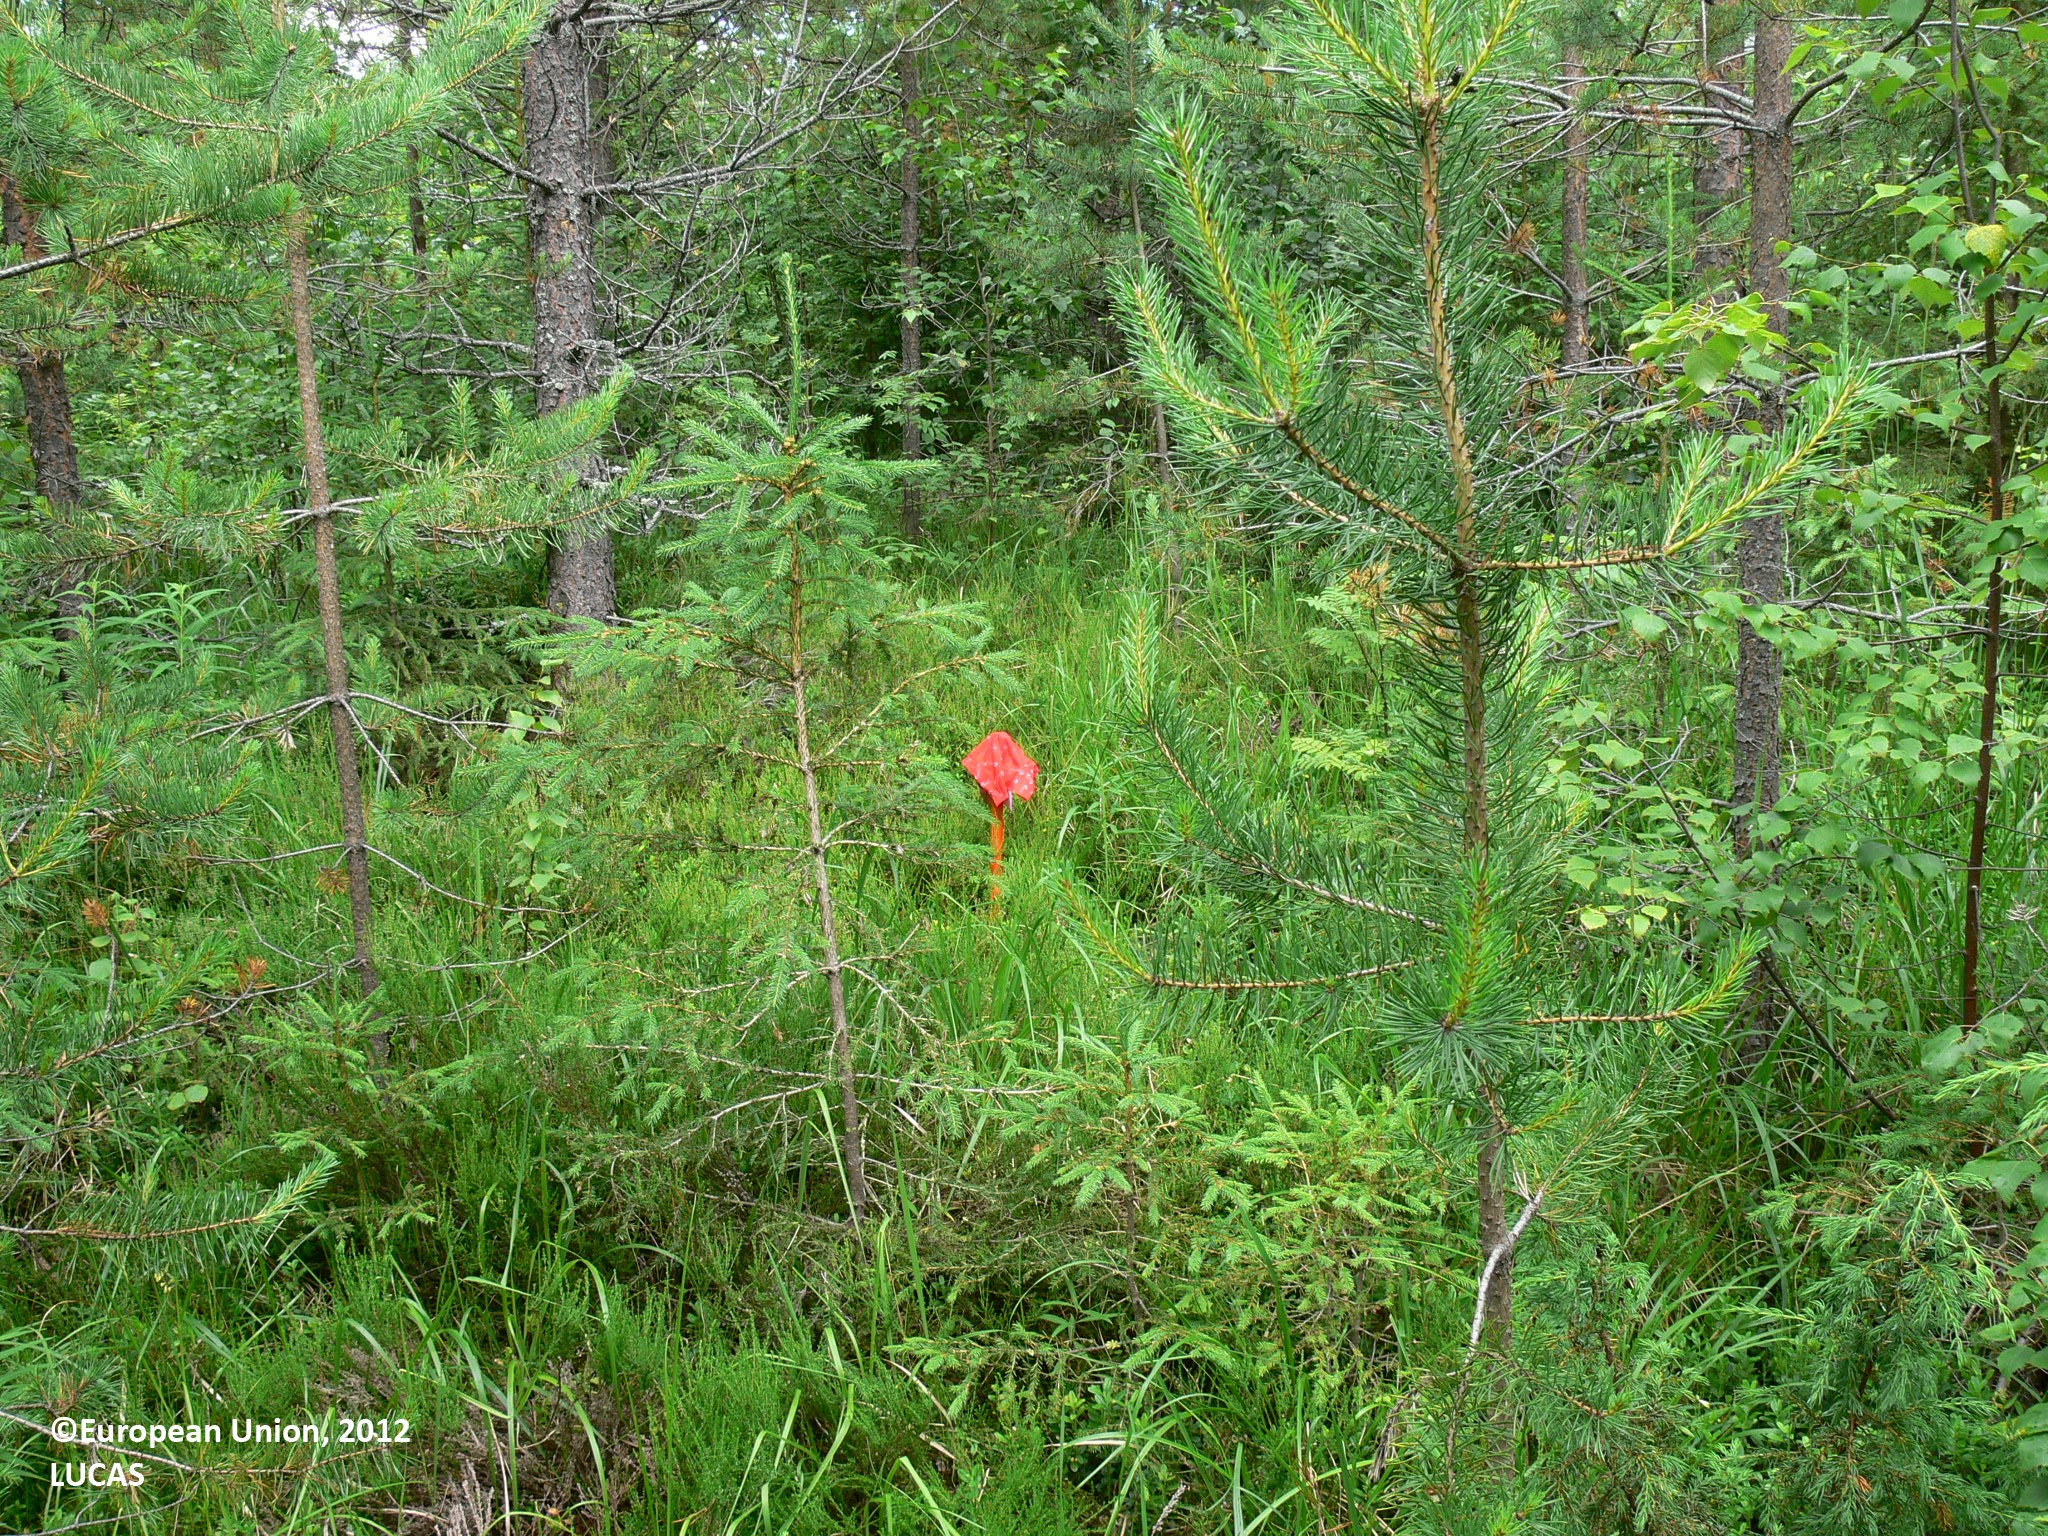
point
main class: Woodland
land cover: Pine dominated mixed woodland
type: boreal forest
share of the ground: > 75 %
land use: Forestry
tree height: > 5 m
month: July
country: FI
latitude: 63.0011
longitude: 29.4837
